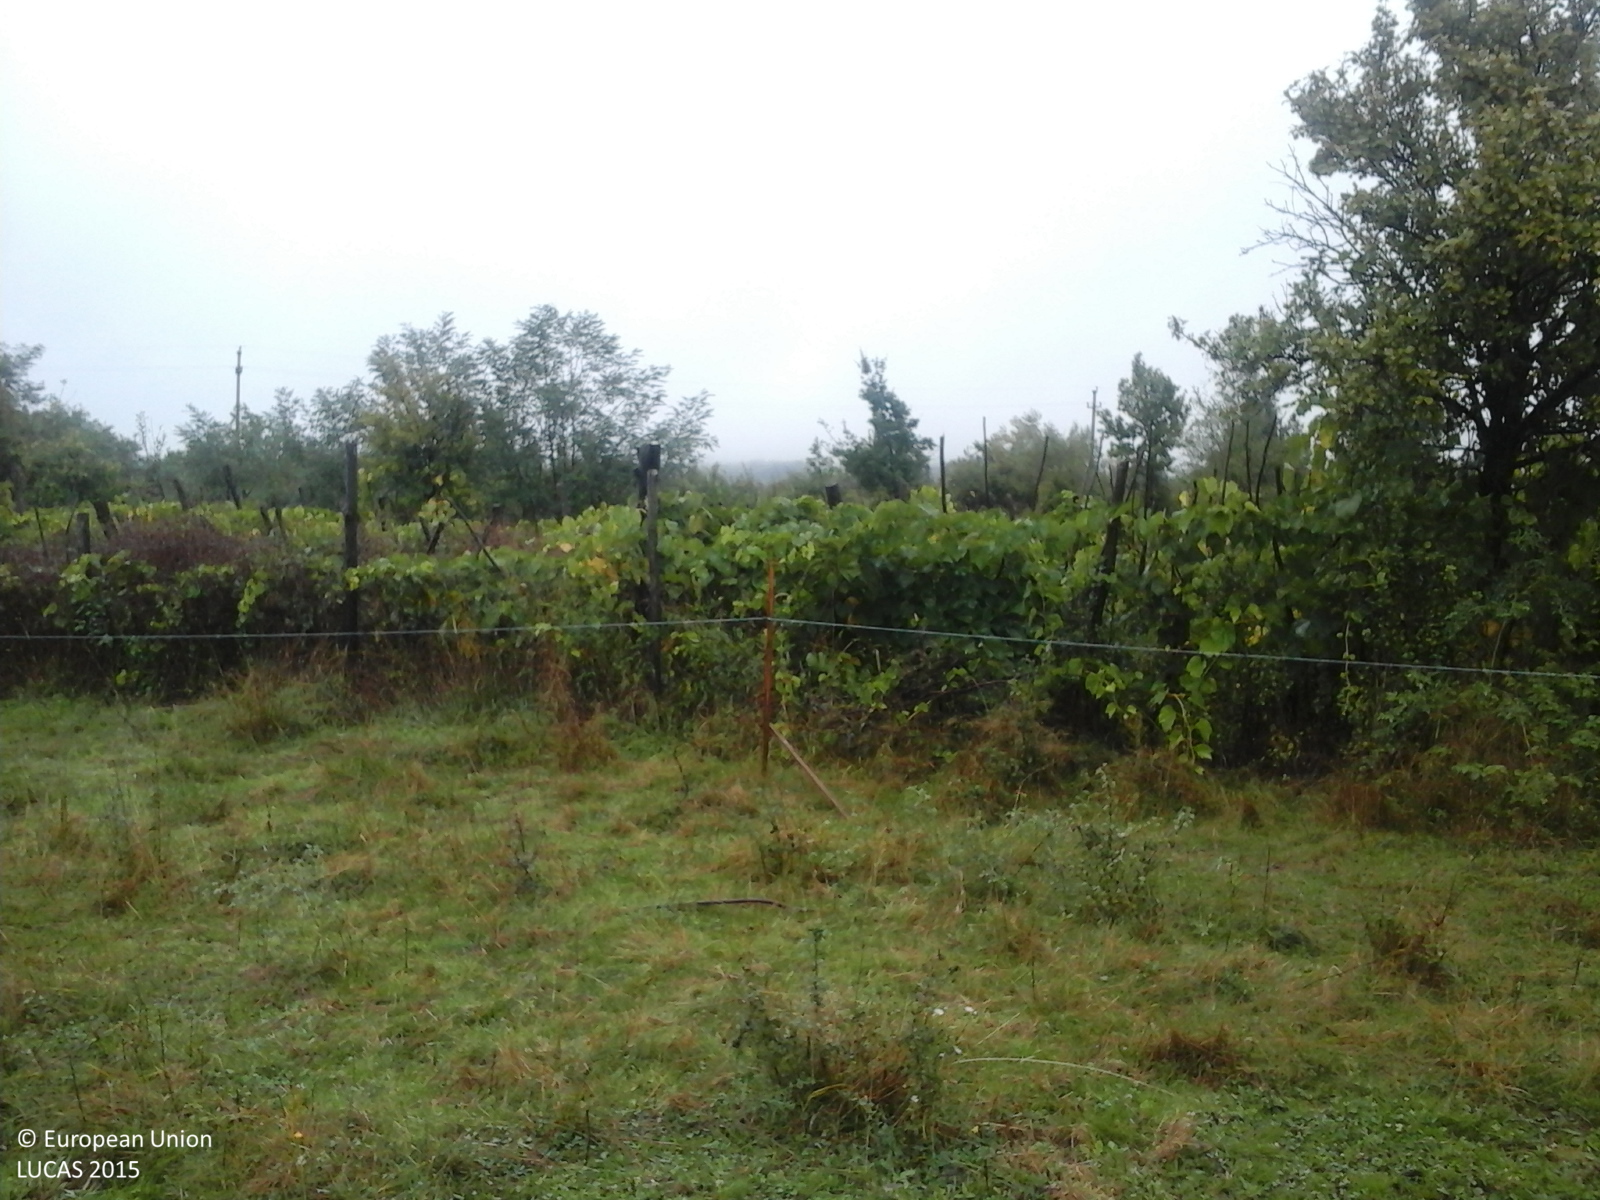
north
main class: Grassland
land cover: Grassland with sparse tree/shrub cover
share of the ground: > 75 %
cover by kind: herbaceous plants 85 %, shrubs 10 %, broadleaved forest trees 5 %
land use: Agriculture (excluding fallow land and kitchen gardens)
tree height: < 5 m
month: September
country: RO
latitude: 45.1595
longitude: 23.6602
